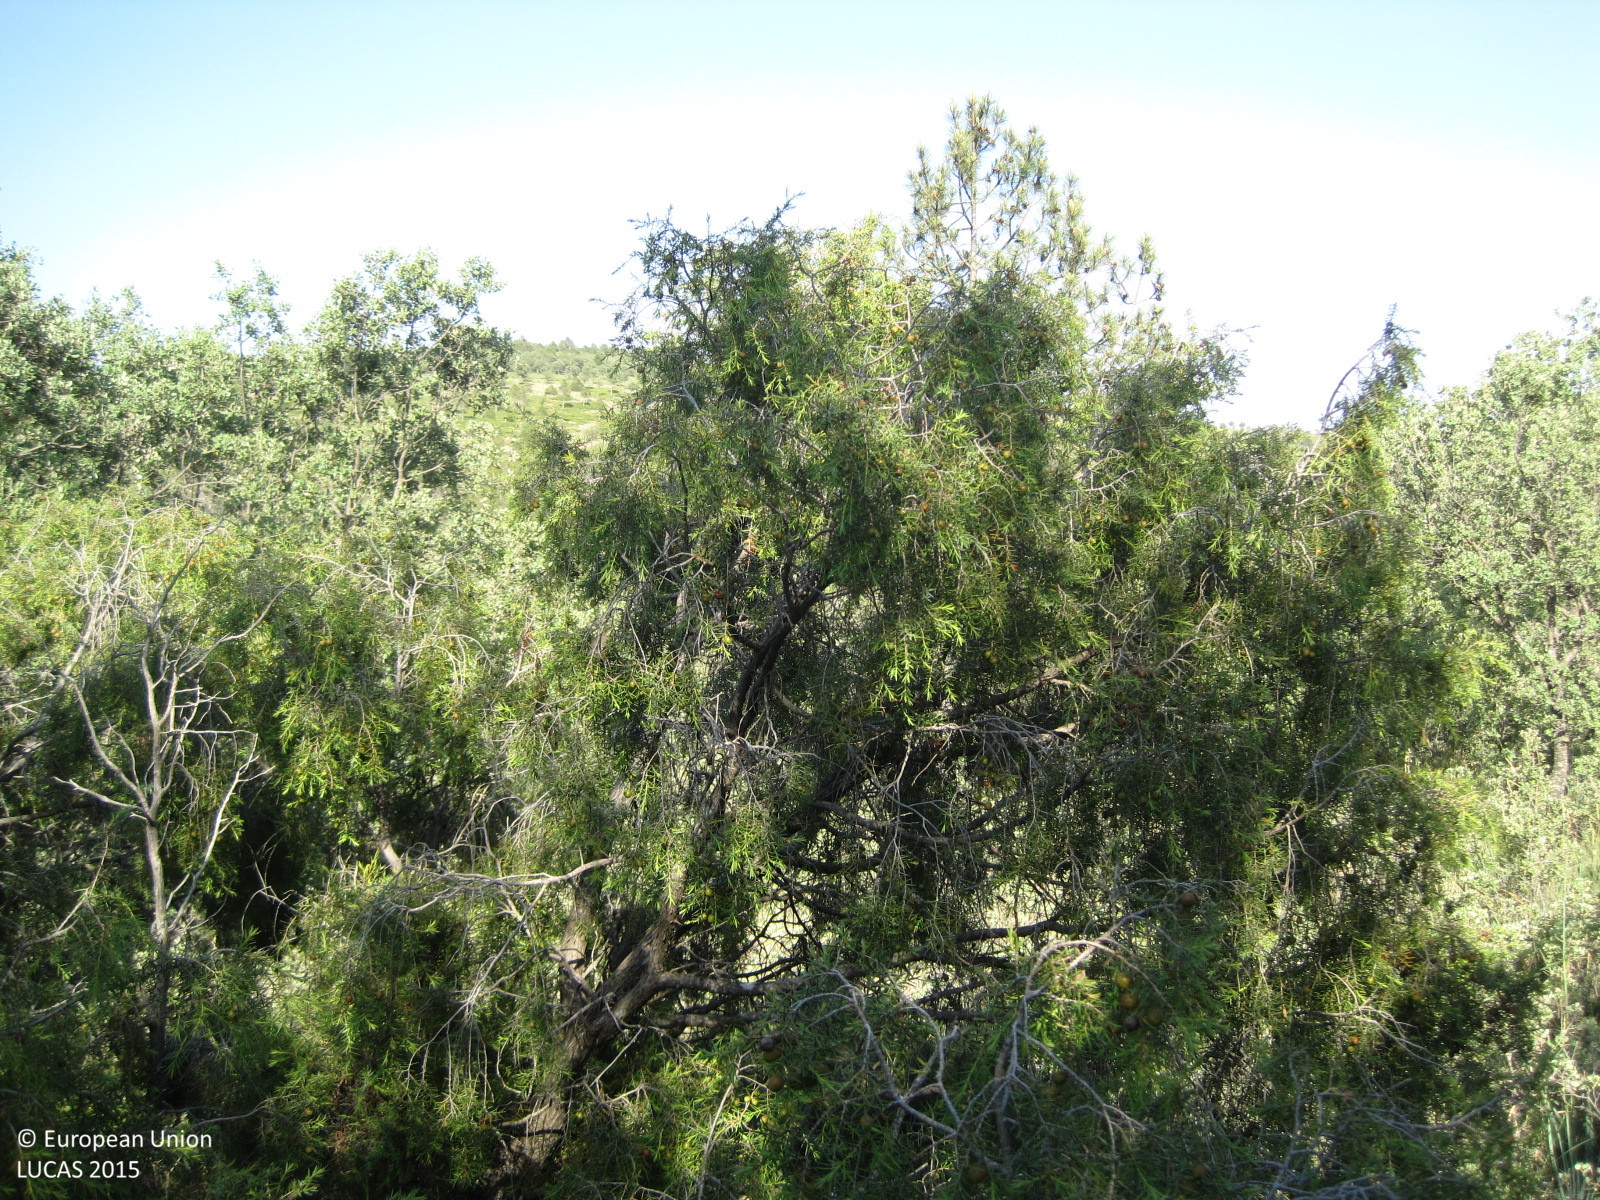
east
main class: Woodland
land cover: Broadleaved woodland
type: thermophilous deciduous forest
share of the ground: > 75 %
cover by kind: broadleaved forest trees 80 %, shrubs 15 %, coniferous forest trees 5 %
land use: Forestry
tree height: > 5 m
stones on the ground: 25 - 50 %
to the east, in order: Broadleaved woodland; Tracks; Pine dominated coniferous woodland; Broadleaved woodland; Other mixed woodland
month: May
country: ES
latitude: 39.6320
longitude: -1.1298
